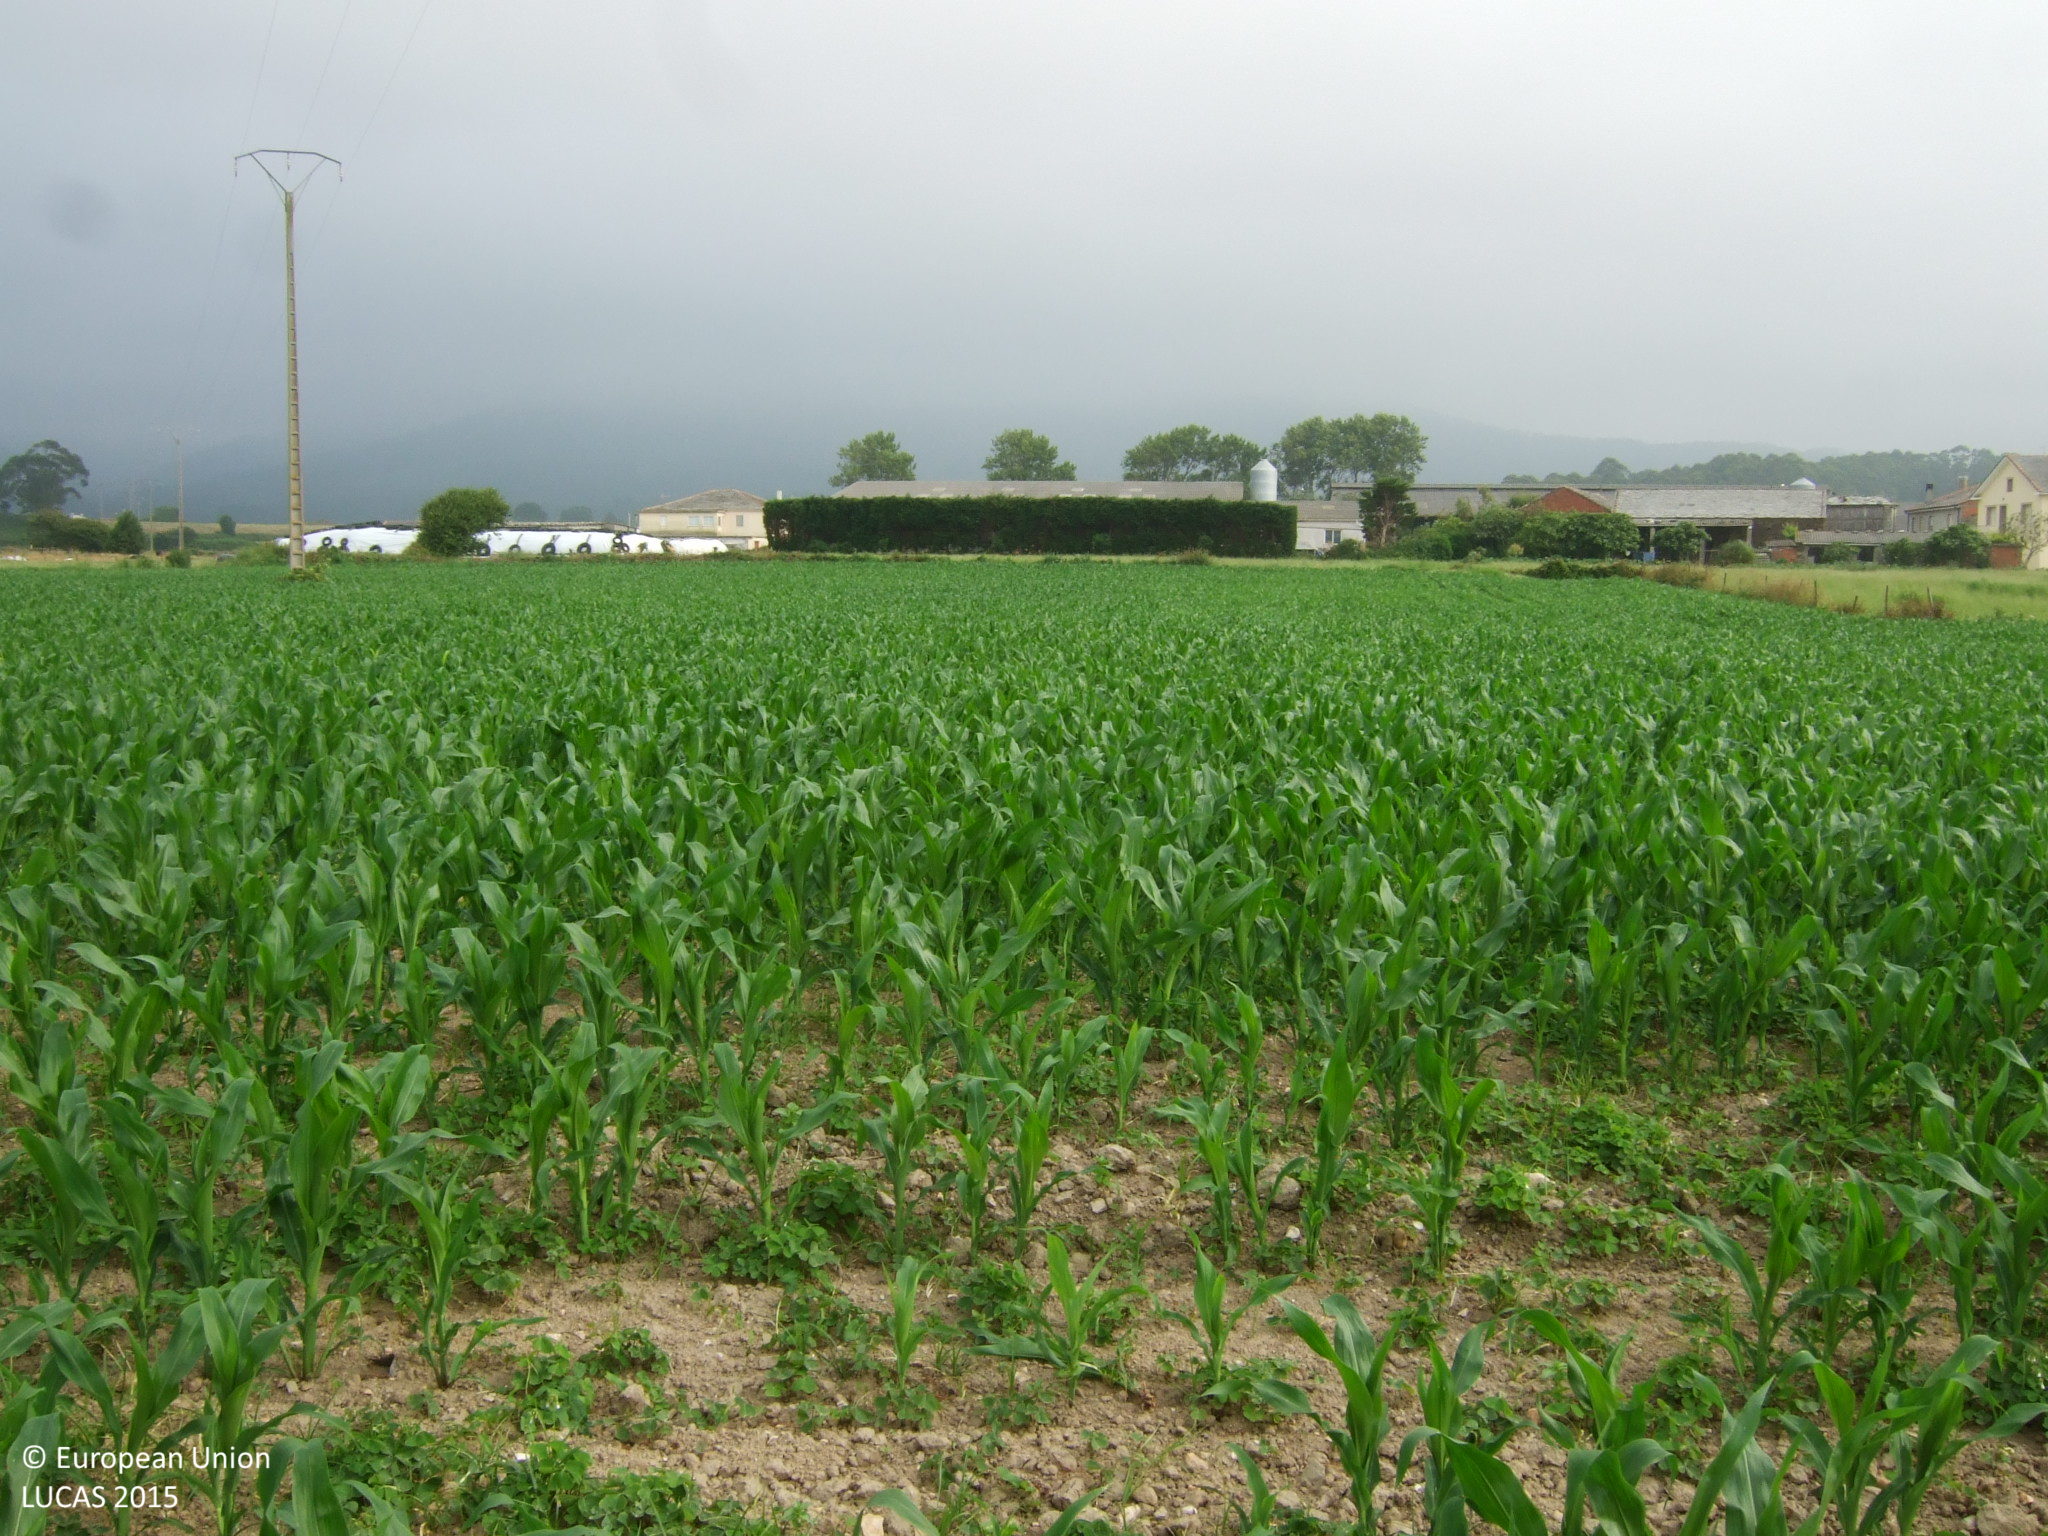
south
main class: Cropland
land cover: Maize
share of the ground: 50 - 75 %
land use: Agriculture (excluding fallow land and kitchen gardens)
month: June
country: ES
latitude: 43.5604
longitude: -7.2206
